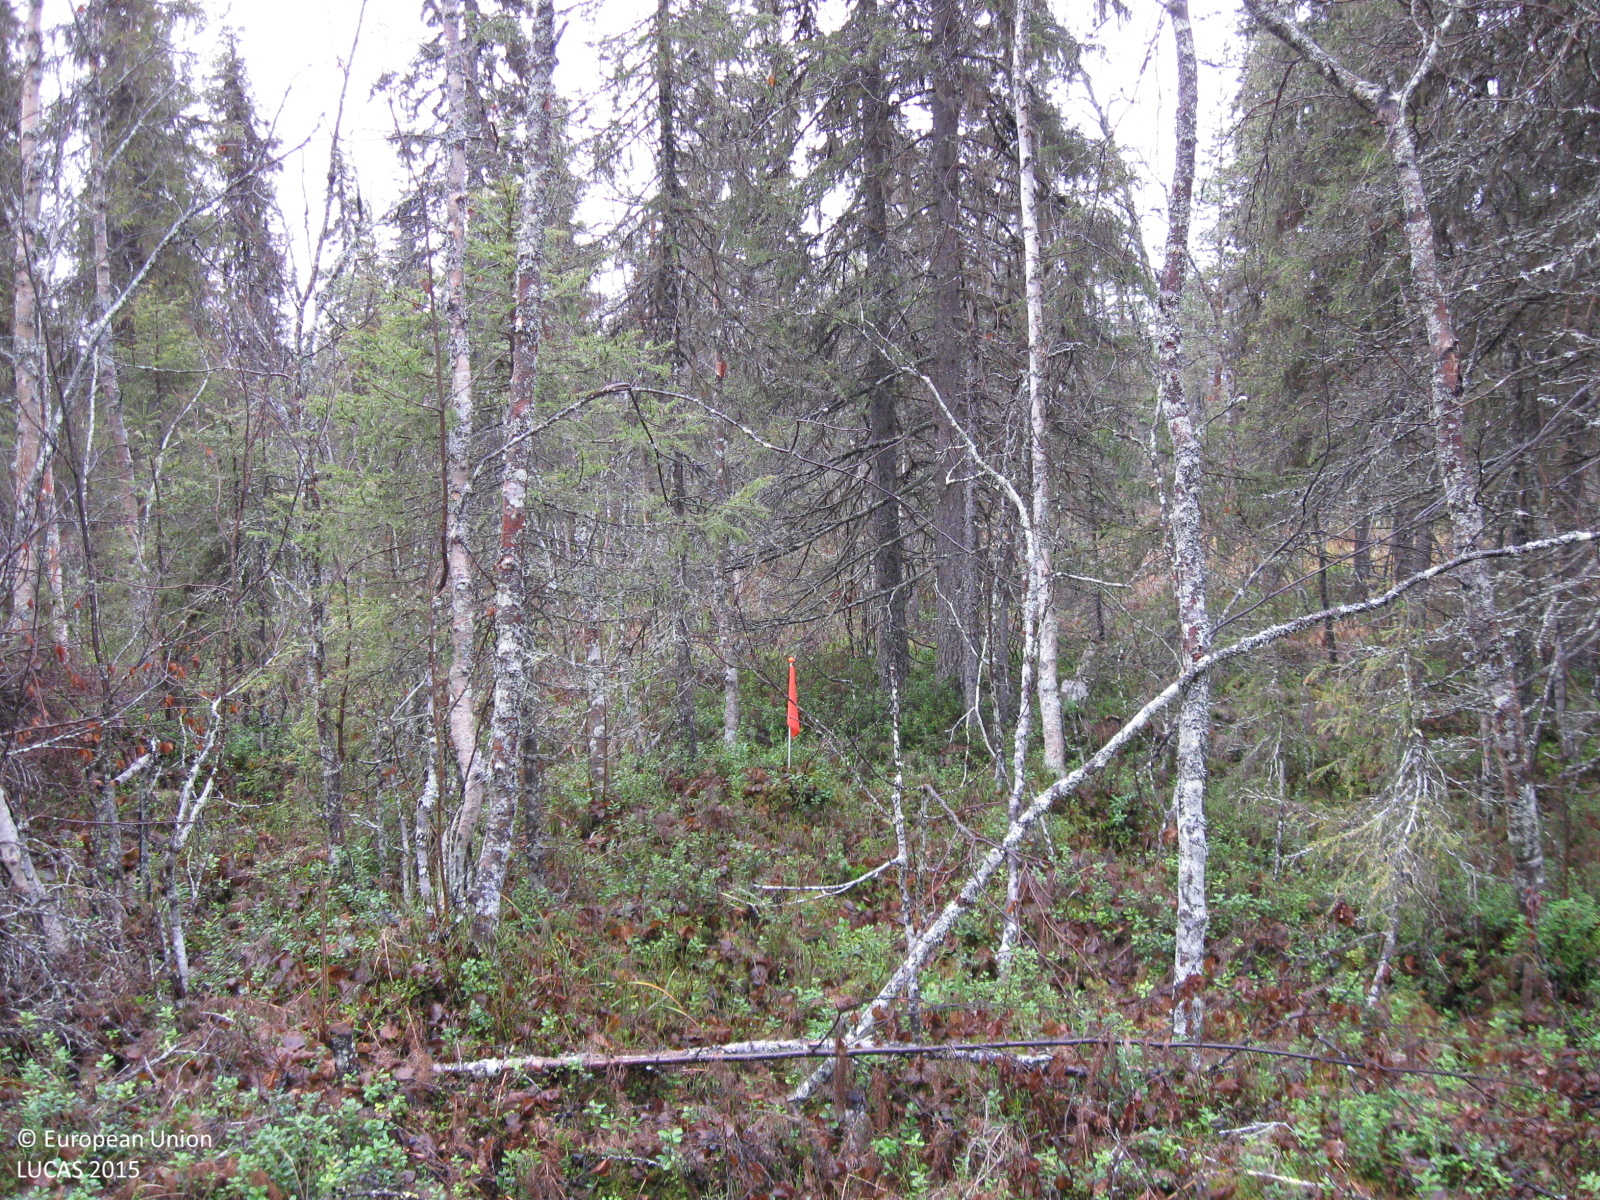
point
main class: Woodland
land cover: Spruce dominated mixed woodland
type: boreal forest
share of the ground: > 75 %
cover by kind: coniferous forest trees 50 %, broadleaved forest trees 30 %, shrubs 10 %, herbaceous plants 5 %, lichens and mosses 5 %
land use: Forestry
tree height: > 5 m
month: October
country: SE
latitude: 66.7548
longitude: 21.0596
